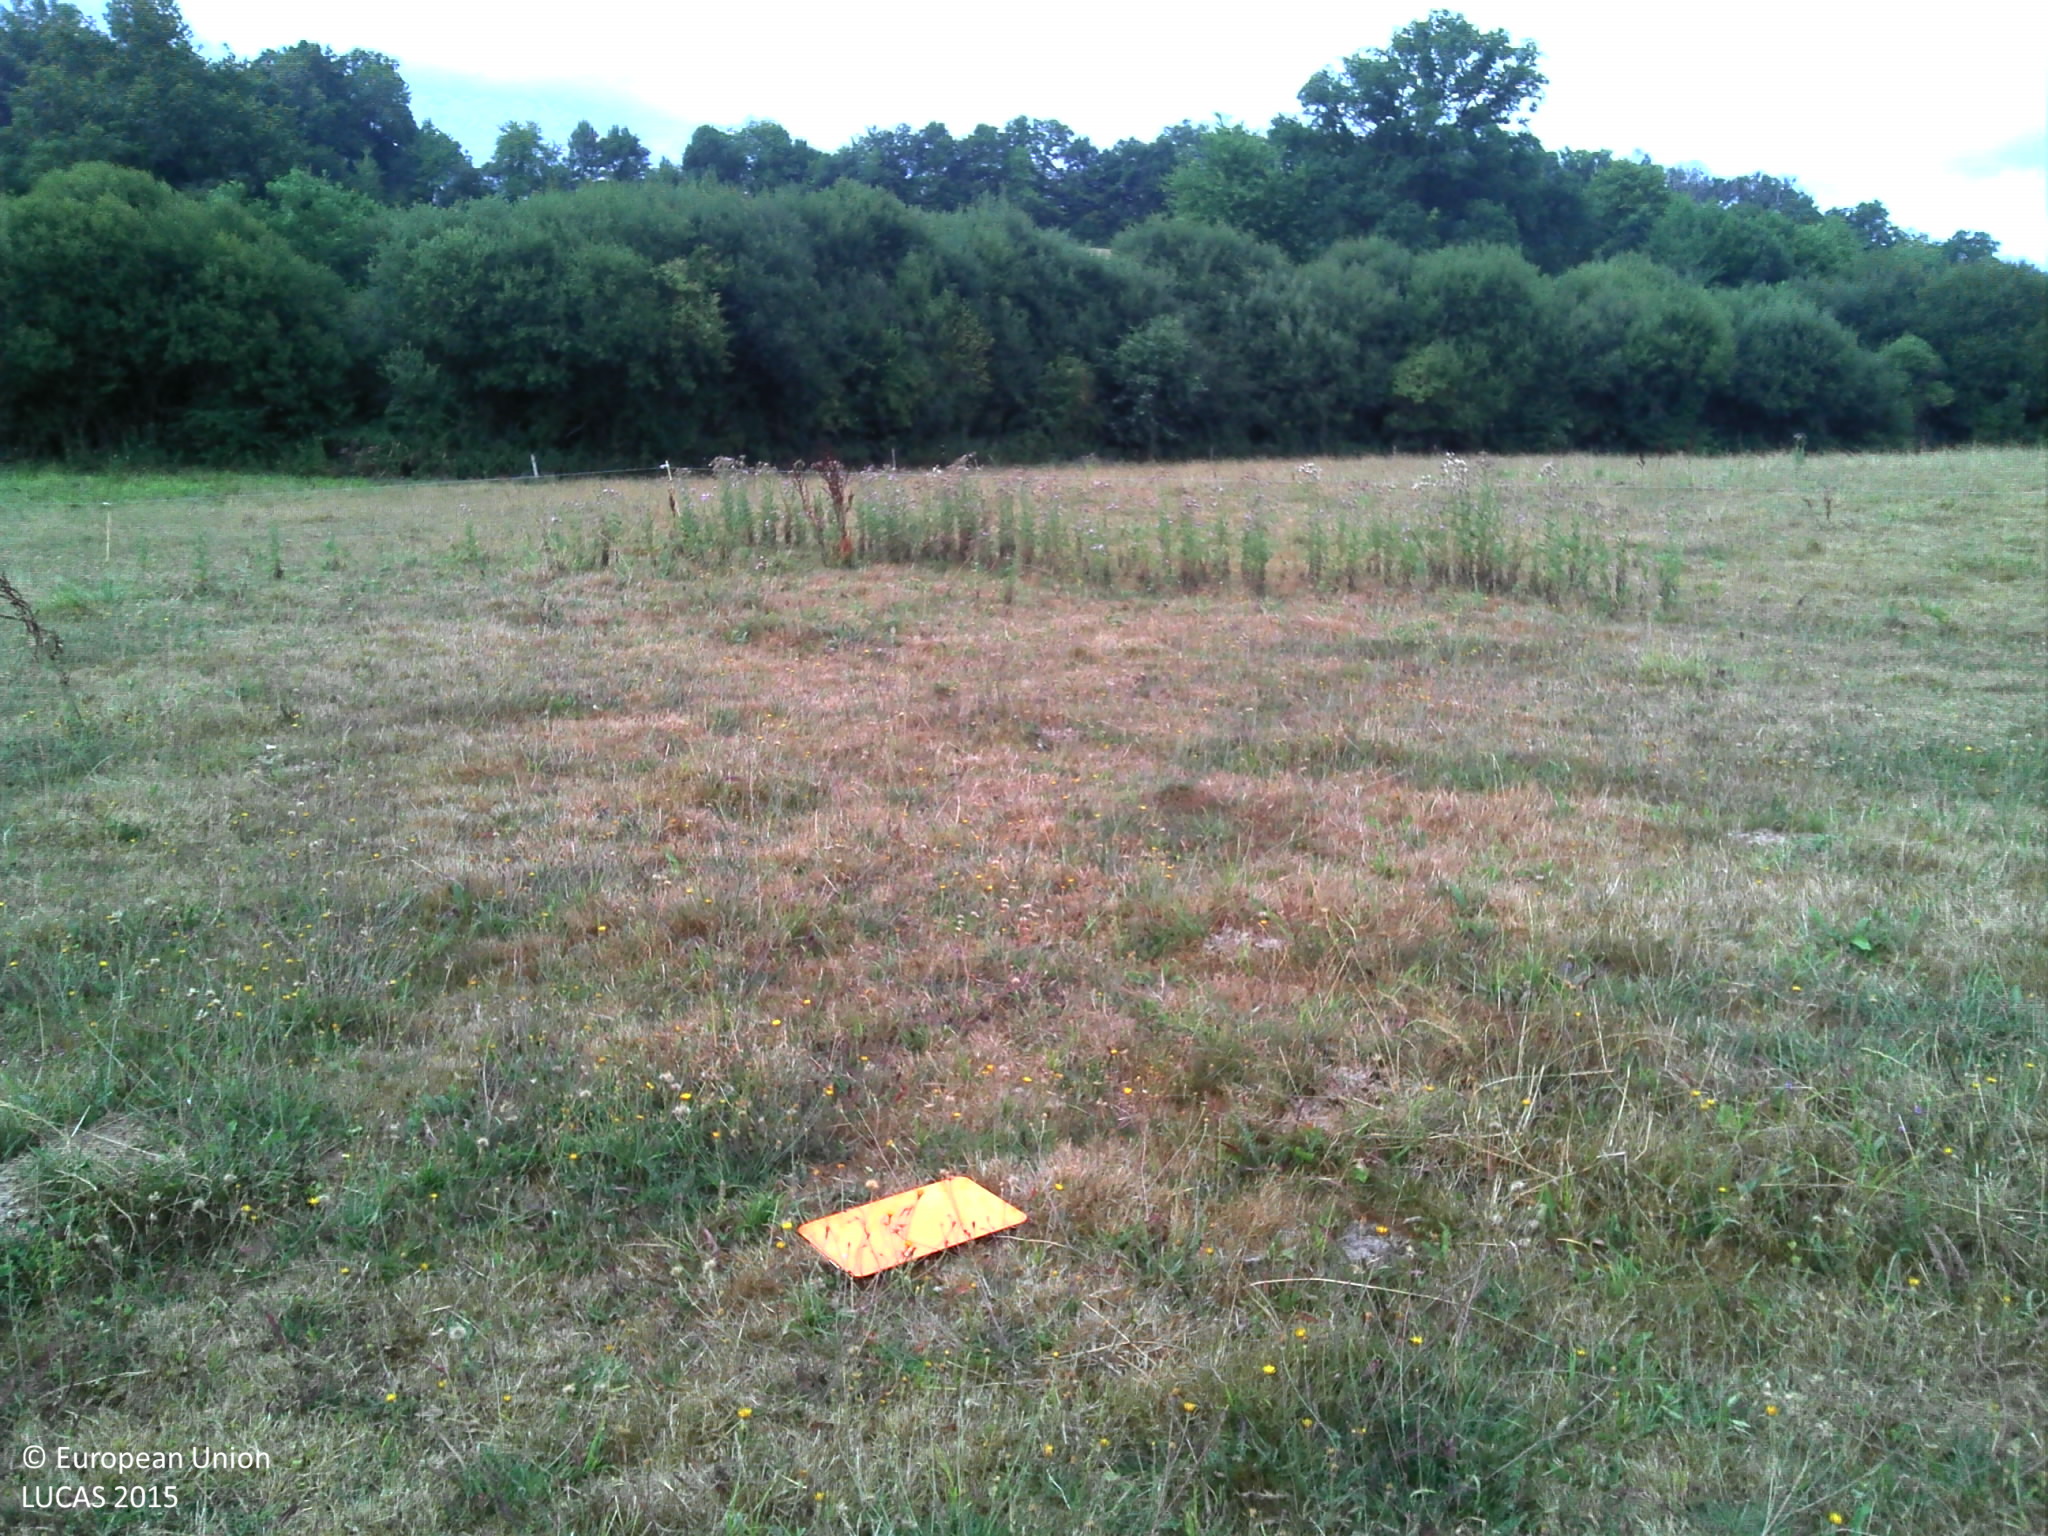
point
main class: Grassland
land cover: Grassland without tree/shrub cover
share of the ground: > 75 %
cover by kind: herbaceous plants 100 %
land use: Agriculture (excluding fallow land and kitchen gardens)
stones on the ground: < 10 %
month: July
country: FR
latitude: 45.4777
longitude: 1.3836
